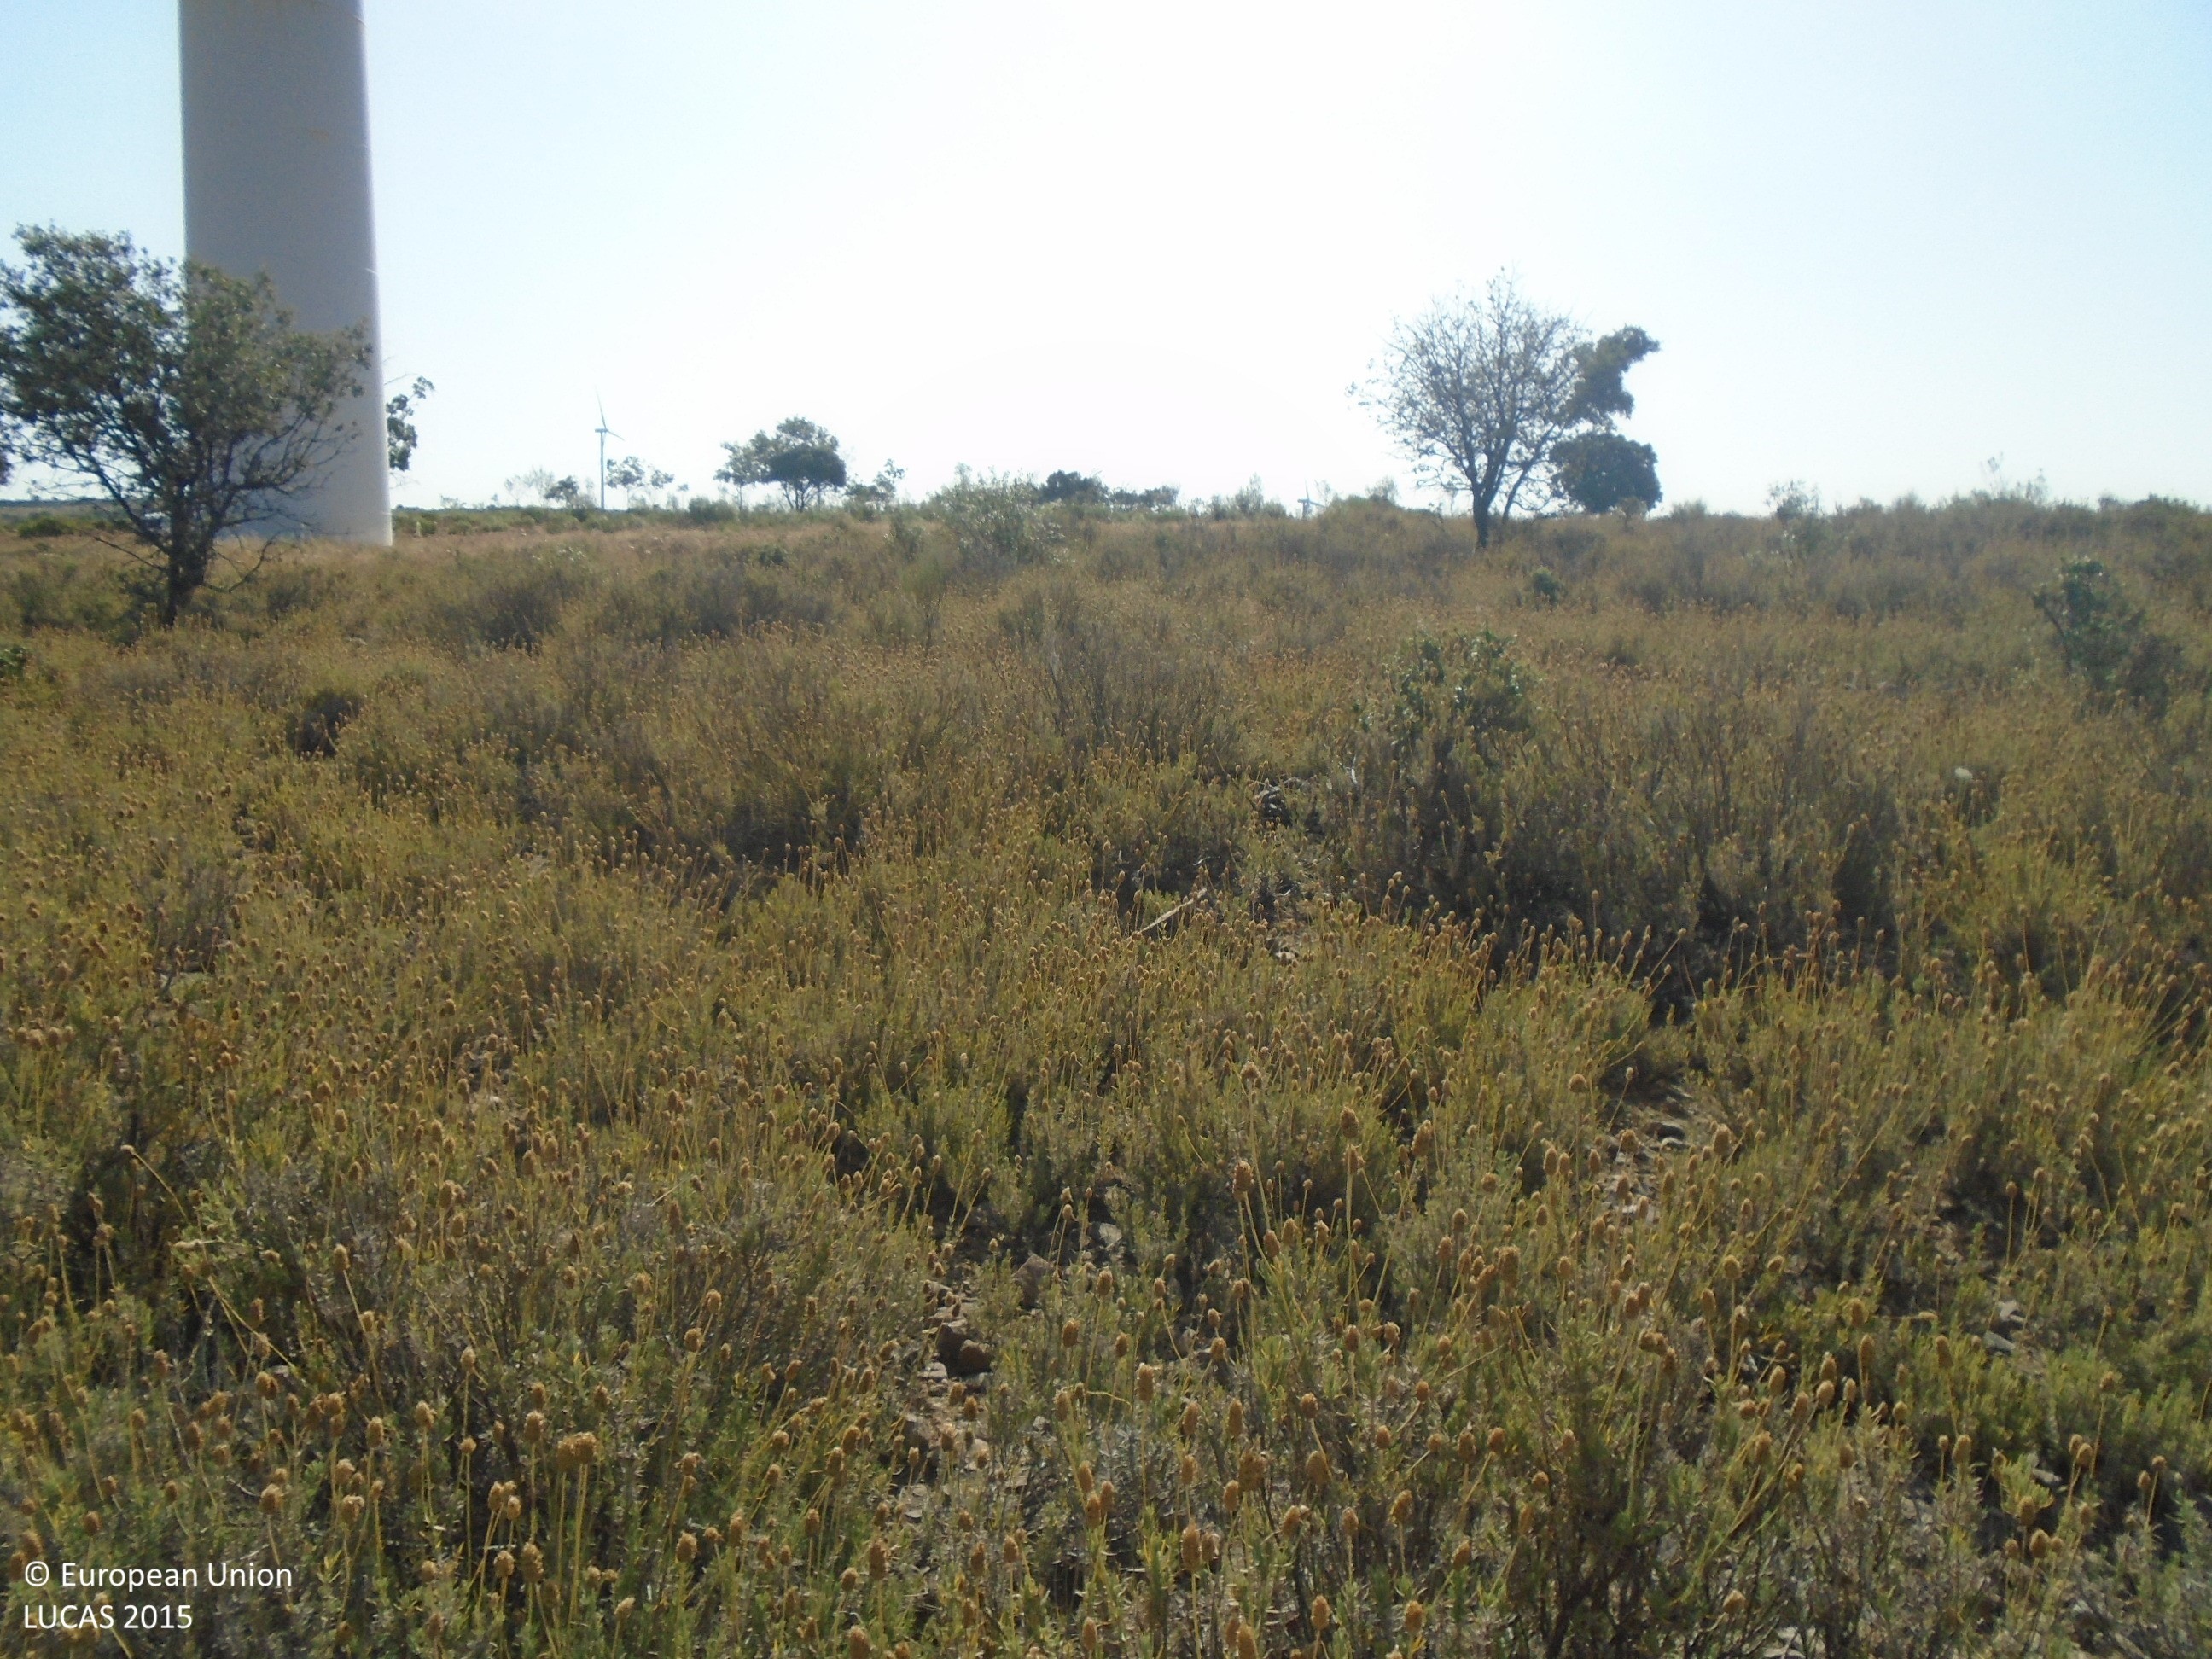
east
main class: Shrubland
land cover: Shrubland without tree cover
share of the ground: > 75 %
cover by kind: shrubs 100 %
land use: Agriculture (excluding fallow land and kitchen gardens)
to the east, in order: Shrubland without tree cover; Tracks; Shrubland with sparse tree cover
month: July
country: ES
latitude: 39.2850
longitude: -4.0662
